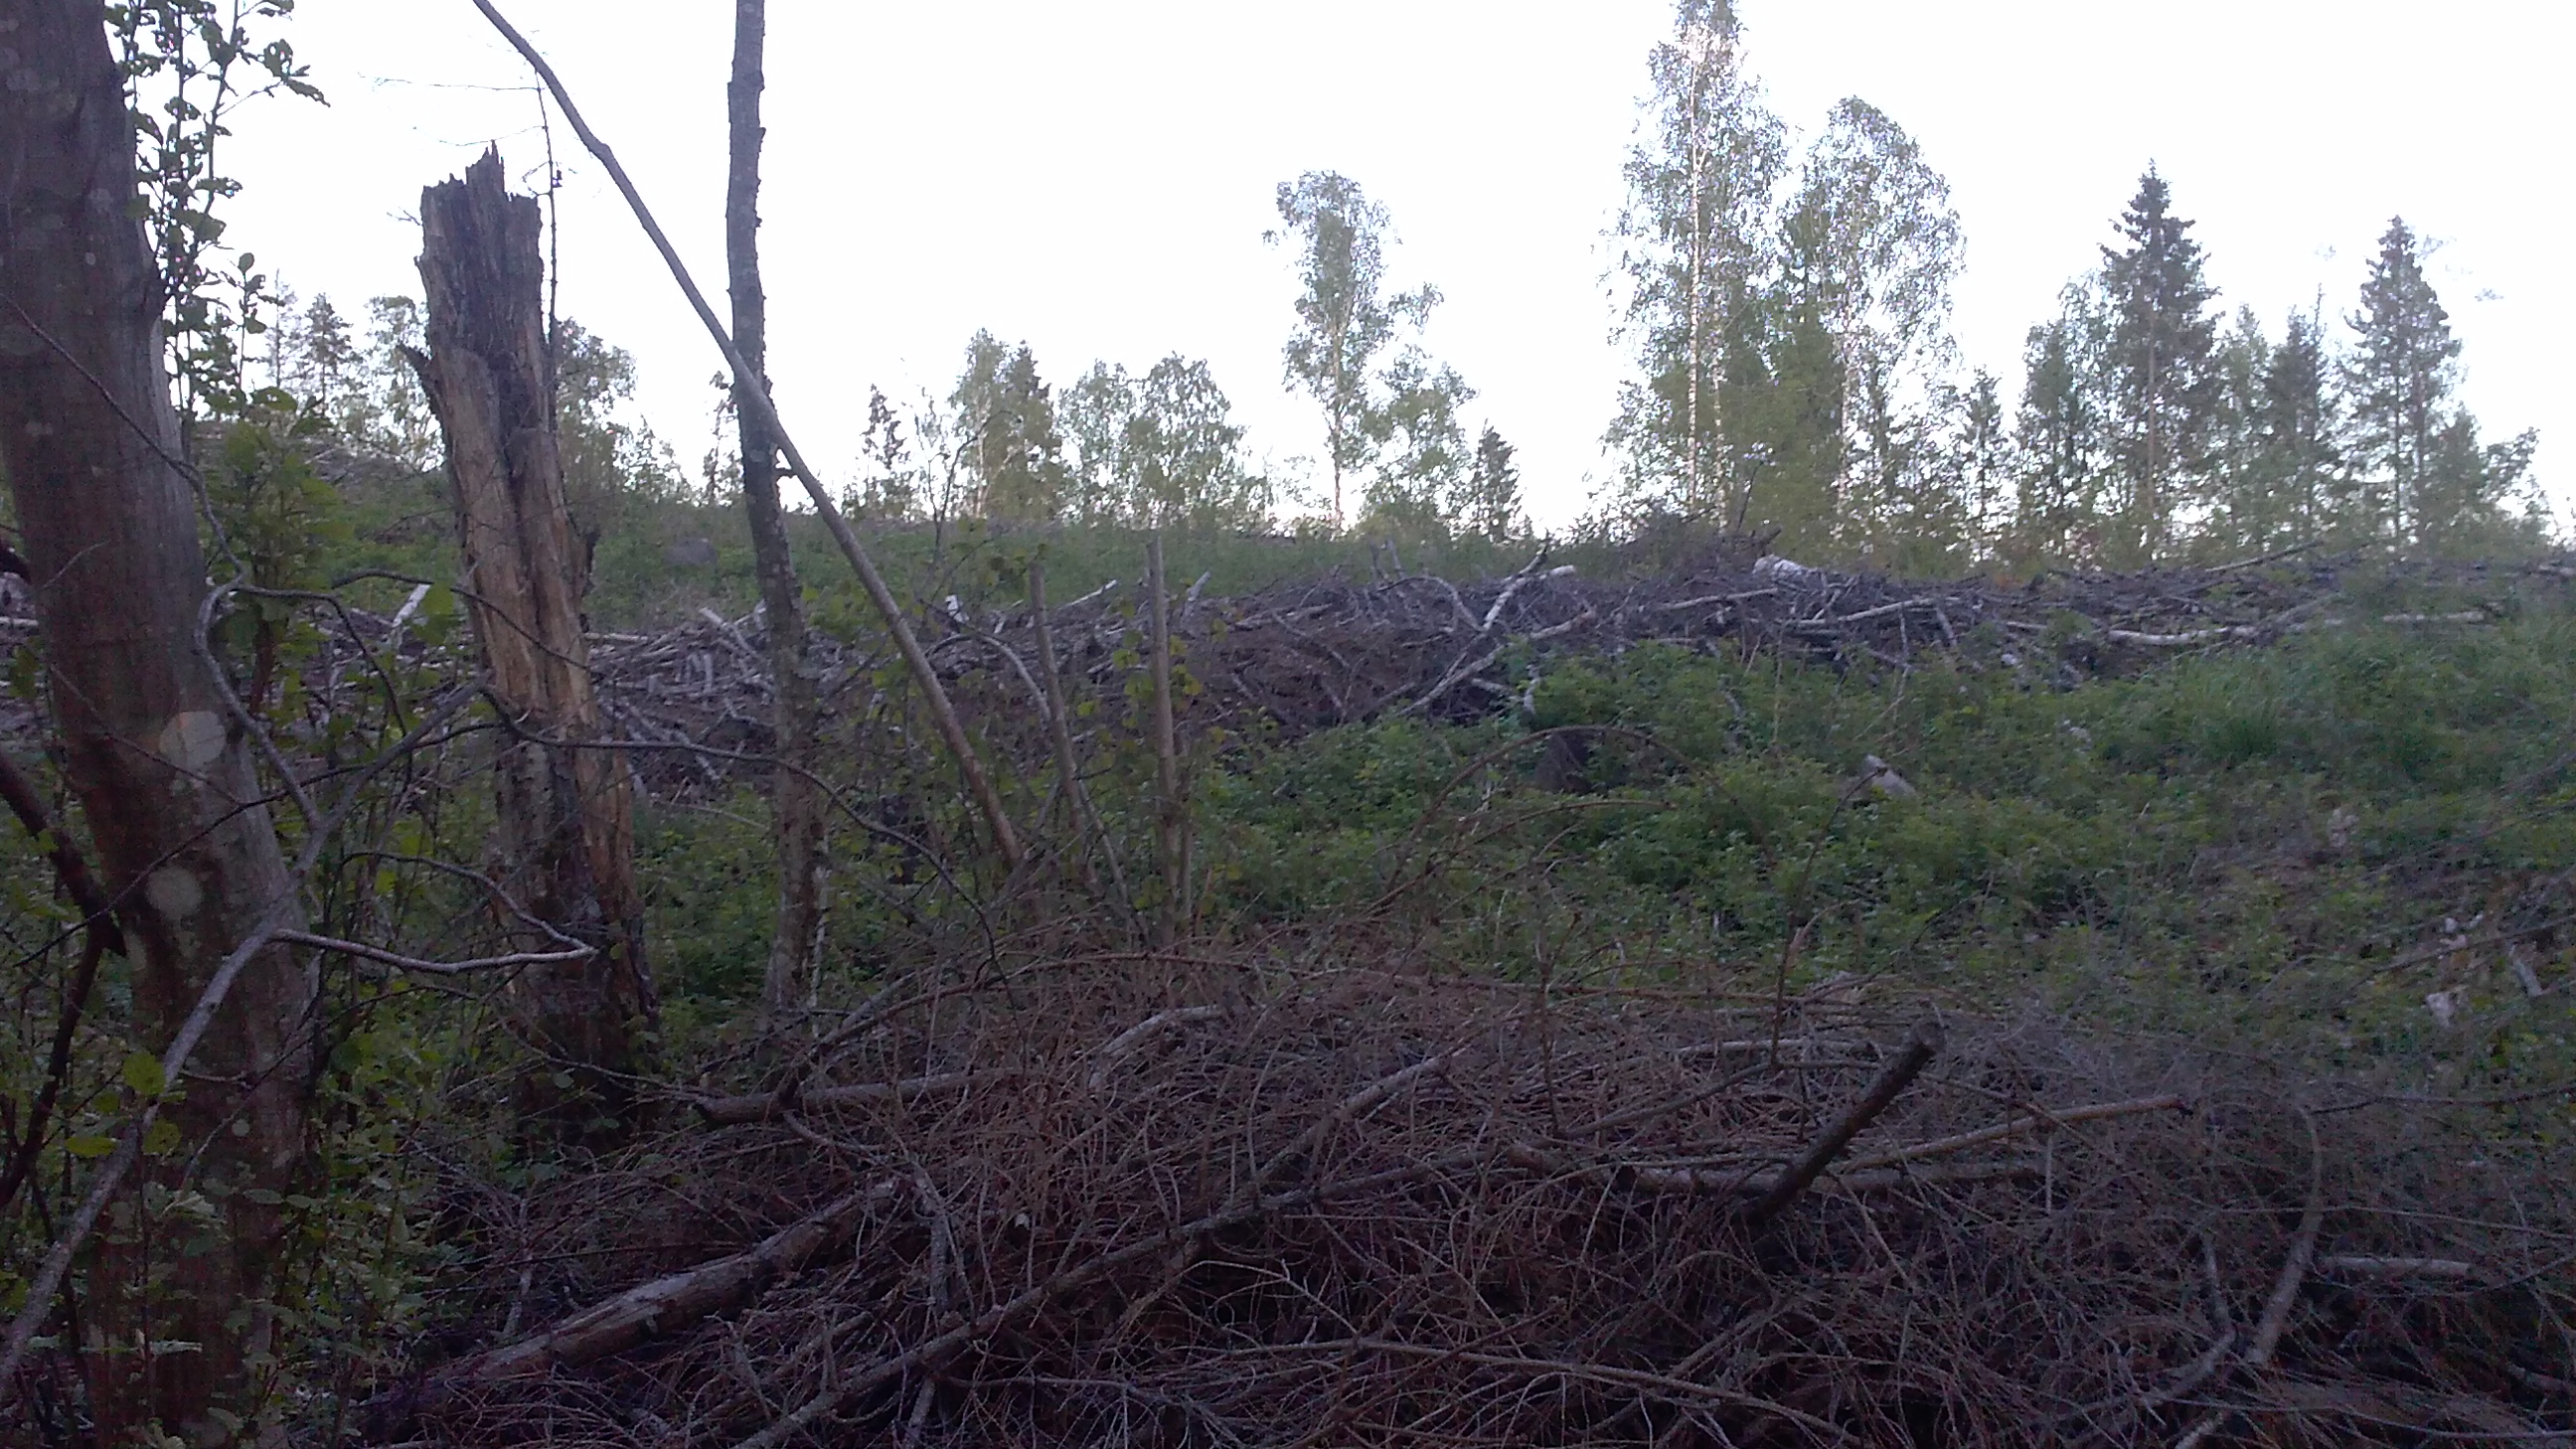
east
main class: Woodland
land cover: Broadleaved woodland
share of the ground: 50 - 75 %
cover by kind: broadleaved forest trees 50 %, shrubs 50 %
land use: Forestry
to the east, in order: Broadleaved woodland; Inland marshes; Other mixed woodland
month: May
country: LV
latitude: 56.0707
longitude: 27.8143
